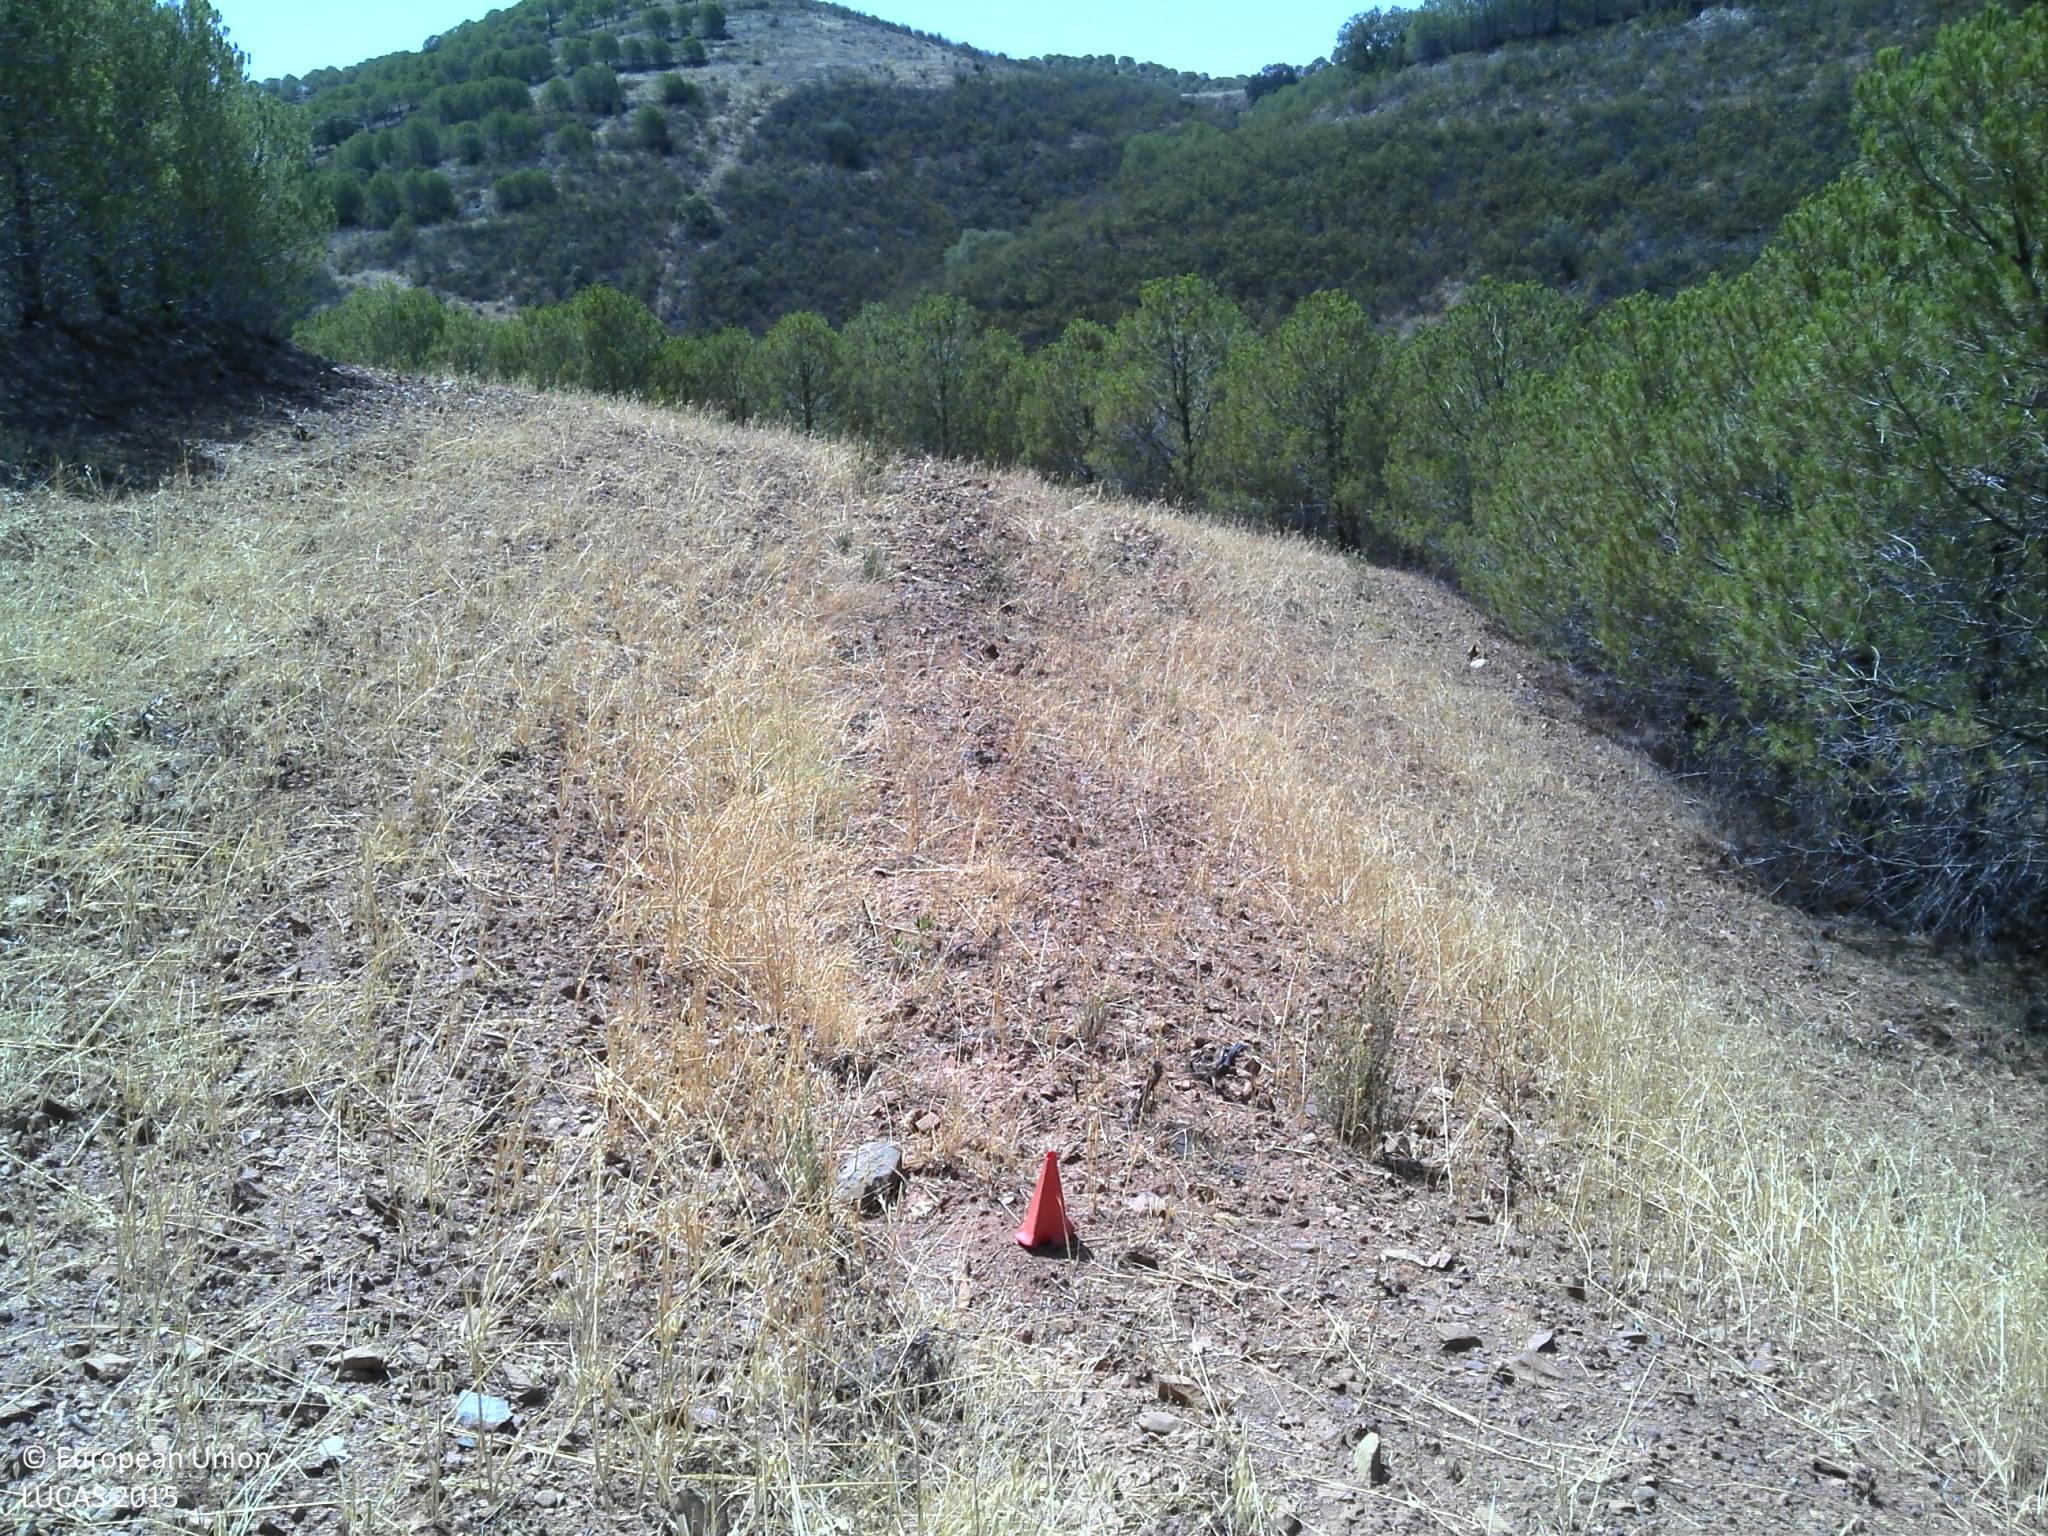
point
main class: Woodland
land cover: Pine dominated coniferous woodland
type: coniferous forest of the mediterranean region
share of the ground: 10 - 25 %
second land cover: Oats
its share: < 10 %
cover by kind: coniferous forest trees 85 %, herbaceous plants 10 %, unconsolidated bare surface 5 %
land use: Forestry
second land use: Agriculture (excluding fallow land and kitchen gardens)
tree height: < 5 m
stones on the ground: < 10 %
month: July
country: PT
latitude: 37.4259
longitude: -7.8820
